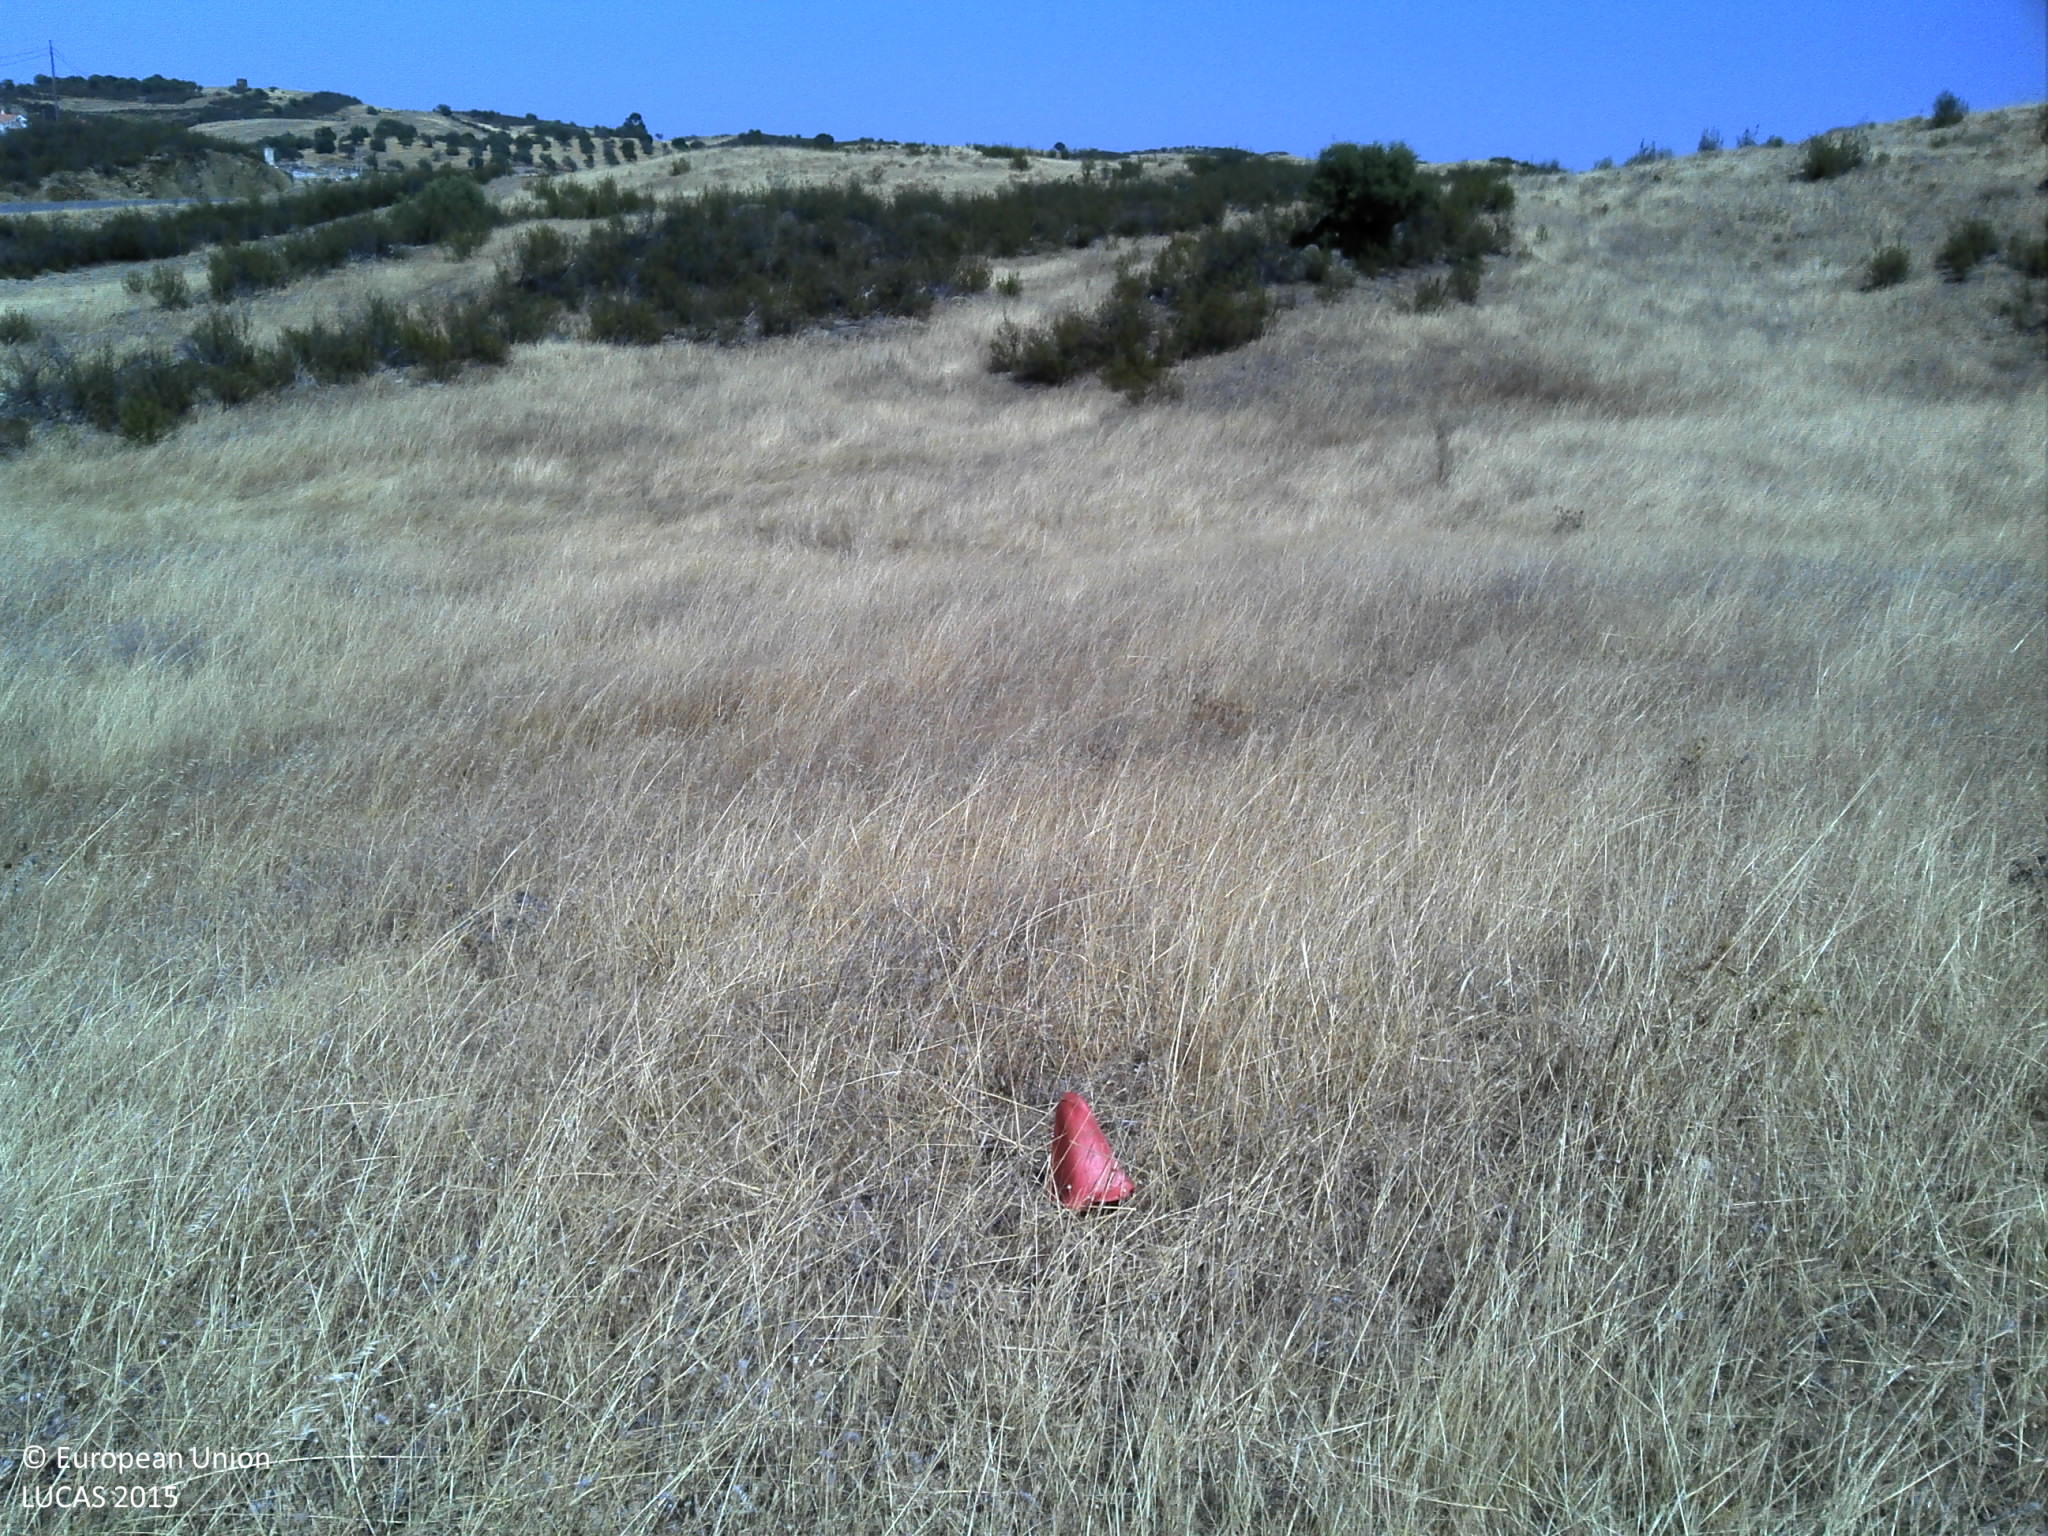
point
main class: Grassland
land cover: Grassland without tree/shrub cover
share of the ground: > 75 %
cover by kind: herbaceous plants 90 %, unconsolidated bare surface 10 %
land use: Agriculture (excluding fallow land and kitchen gardens)
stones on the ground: < 10 %
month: July
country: PT
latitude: 37.5567
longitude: -7.7777
